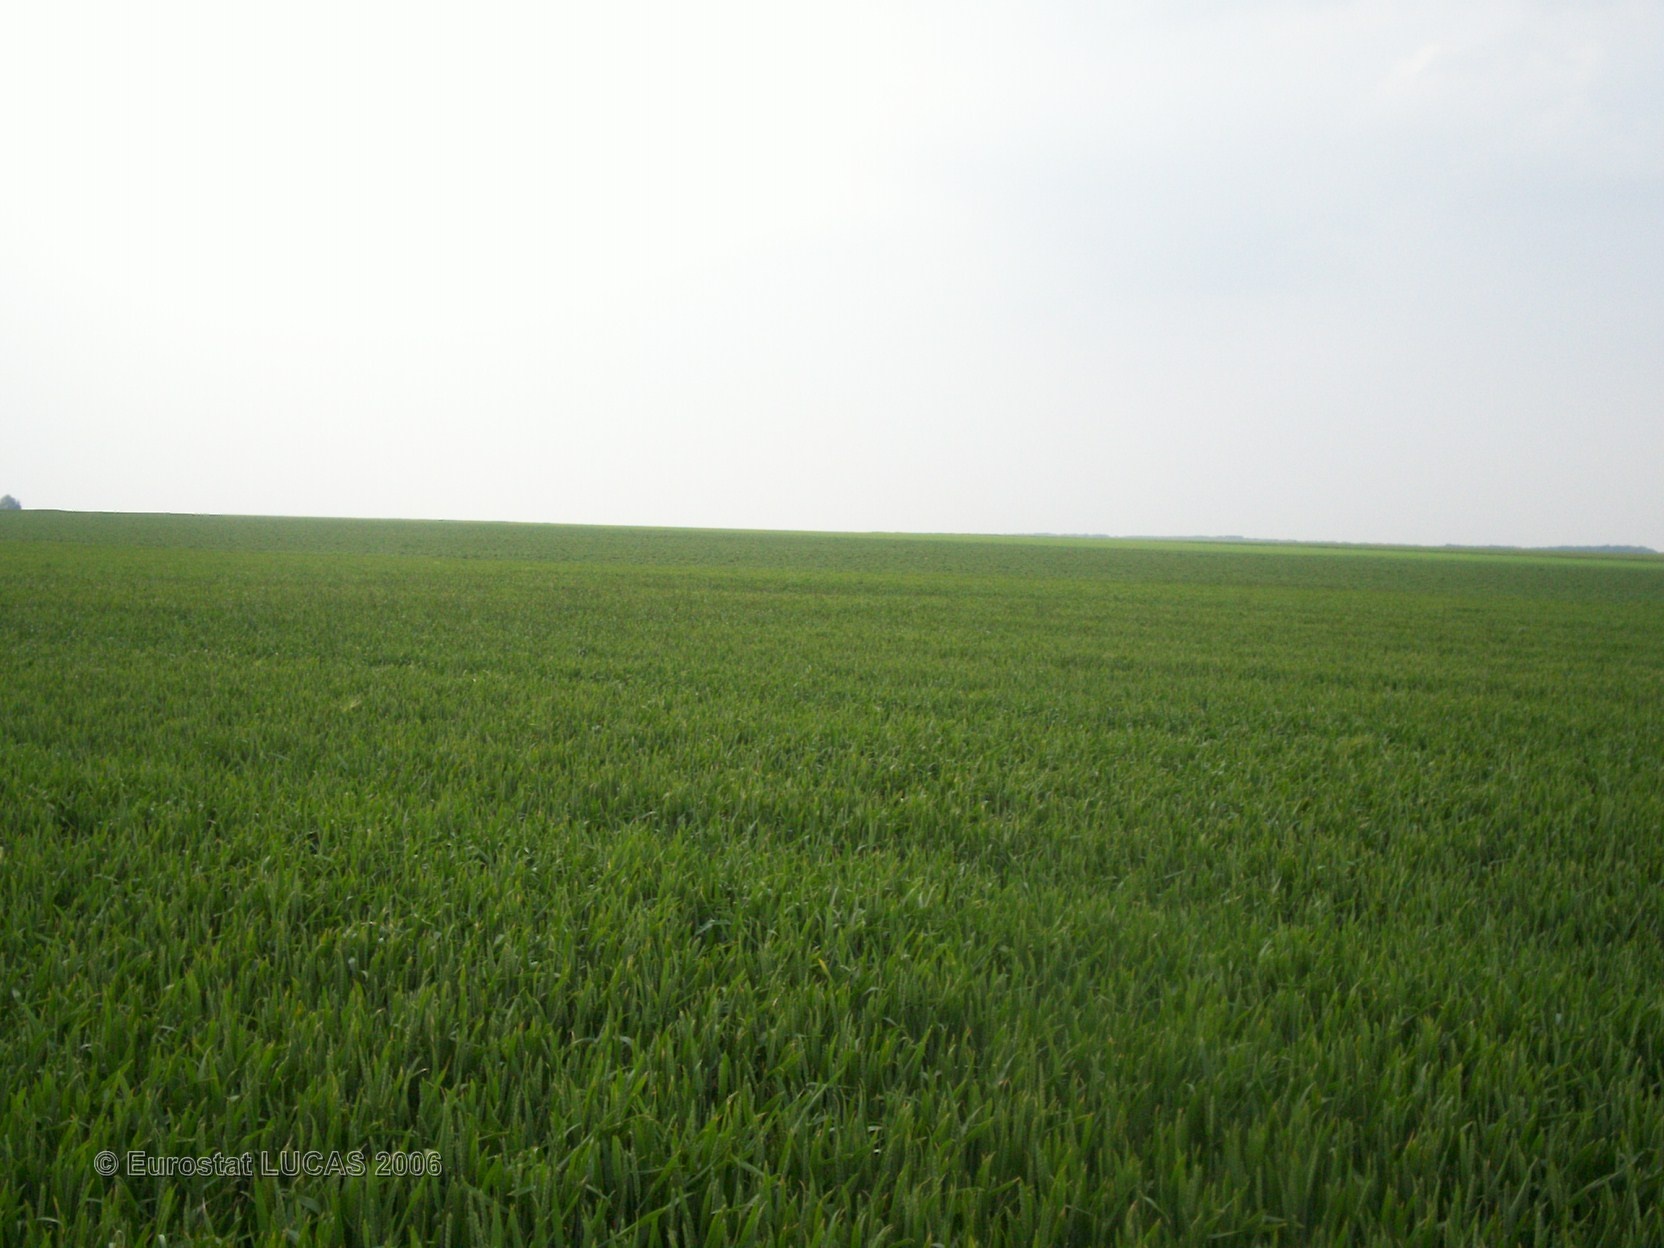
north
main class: Cropland
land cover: Common wheat
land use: Agriculture (excluding fallow land and kitchen gardens)
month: June
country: FR
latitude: 49.6568
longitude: 2.6329
